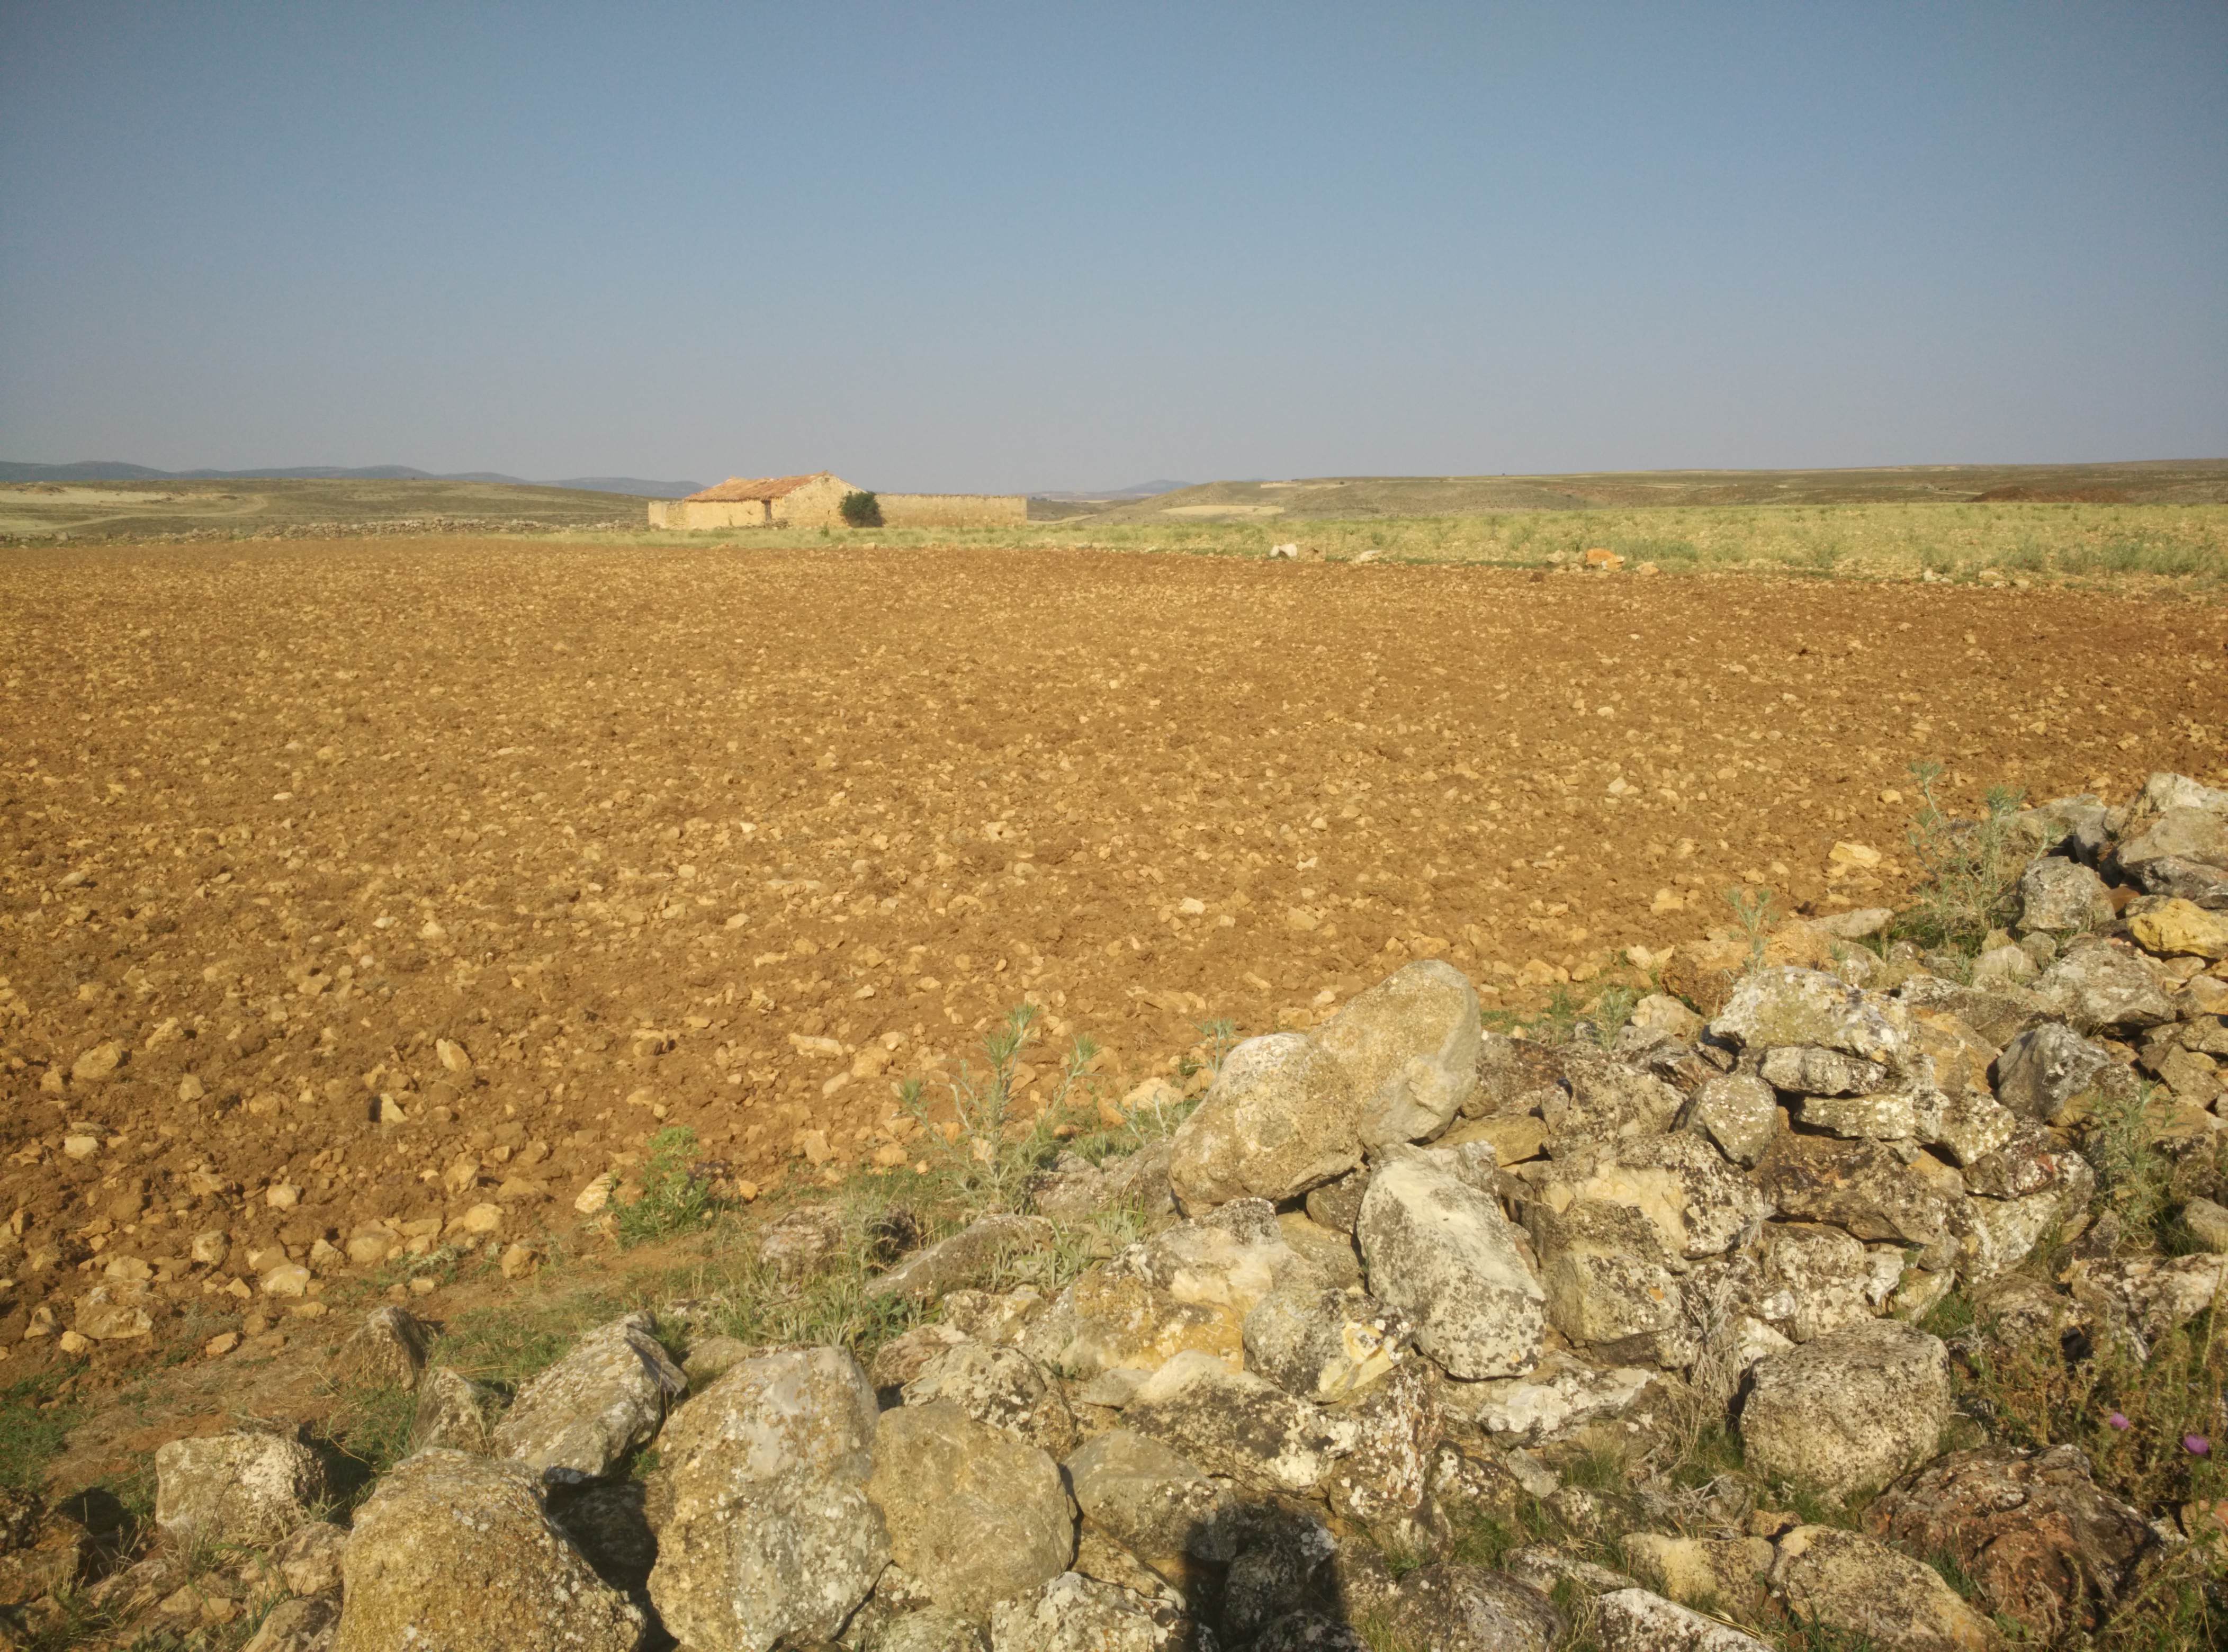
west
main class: Grassland
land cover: Grassland without tree/shrub cover
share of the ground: 50 - 75 %
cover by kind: herbaceous plants 55 %, unconsolidated bare surface 40 %, lichens and mosses 5 %
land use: Agriculture (excluding fallow land and kitchen gardens)
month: June
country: ES
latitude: 40.9767
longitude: -1.8002
